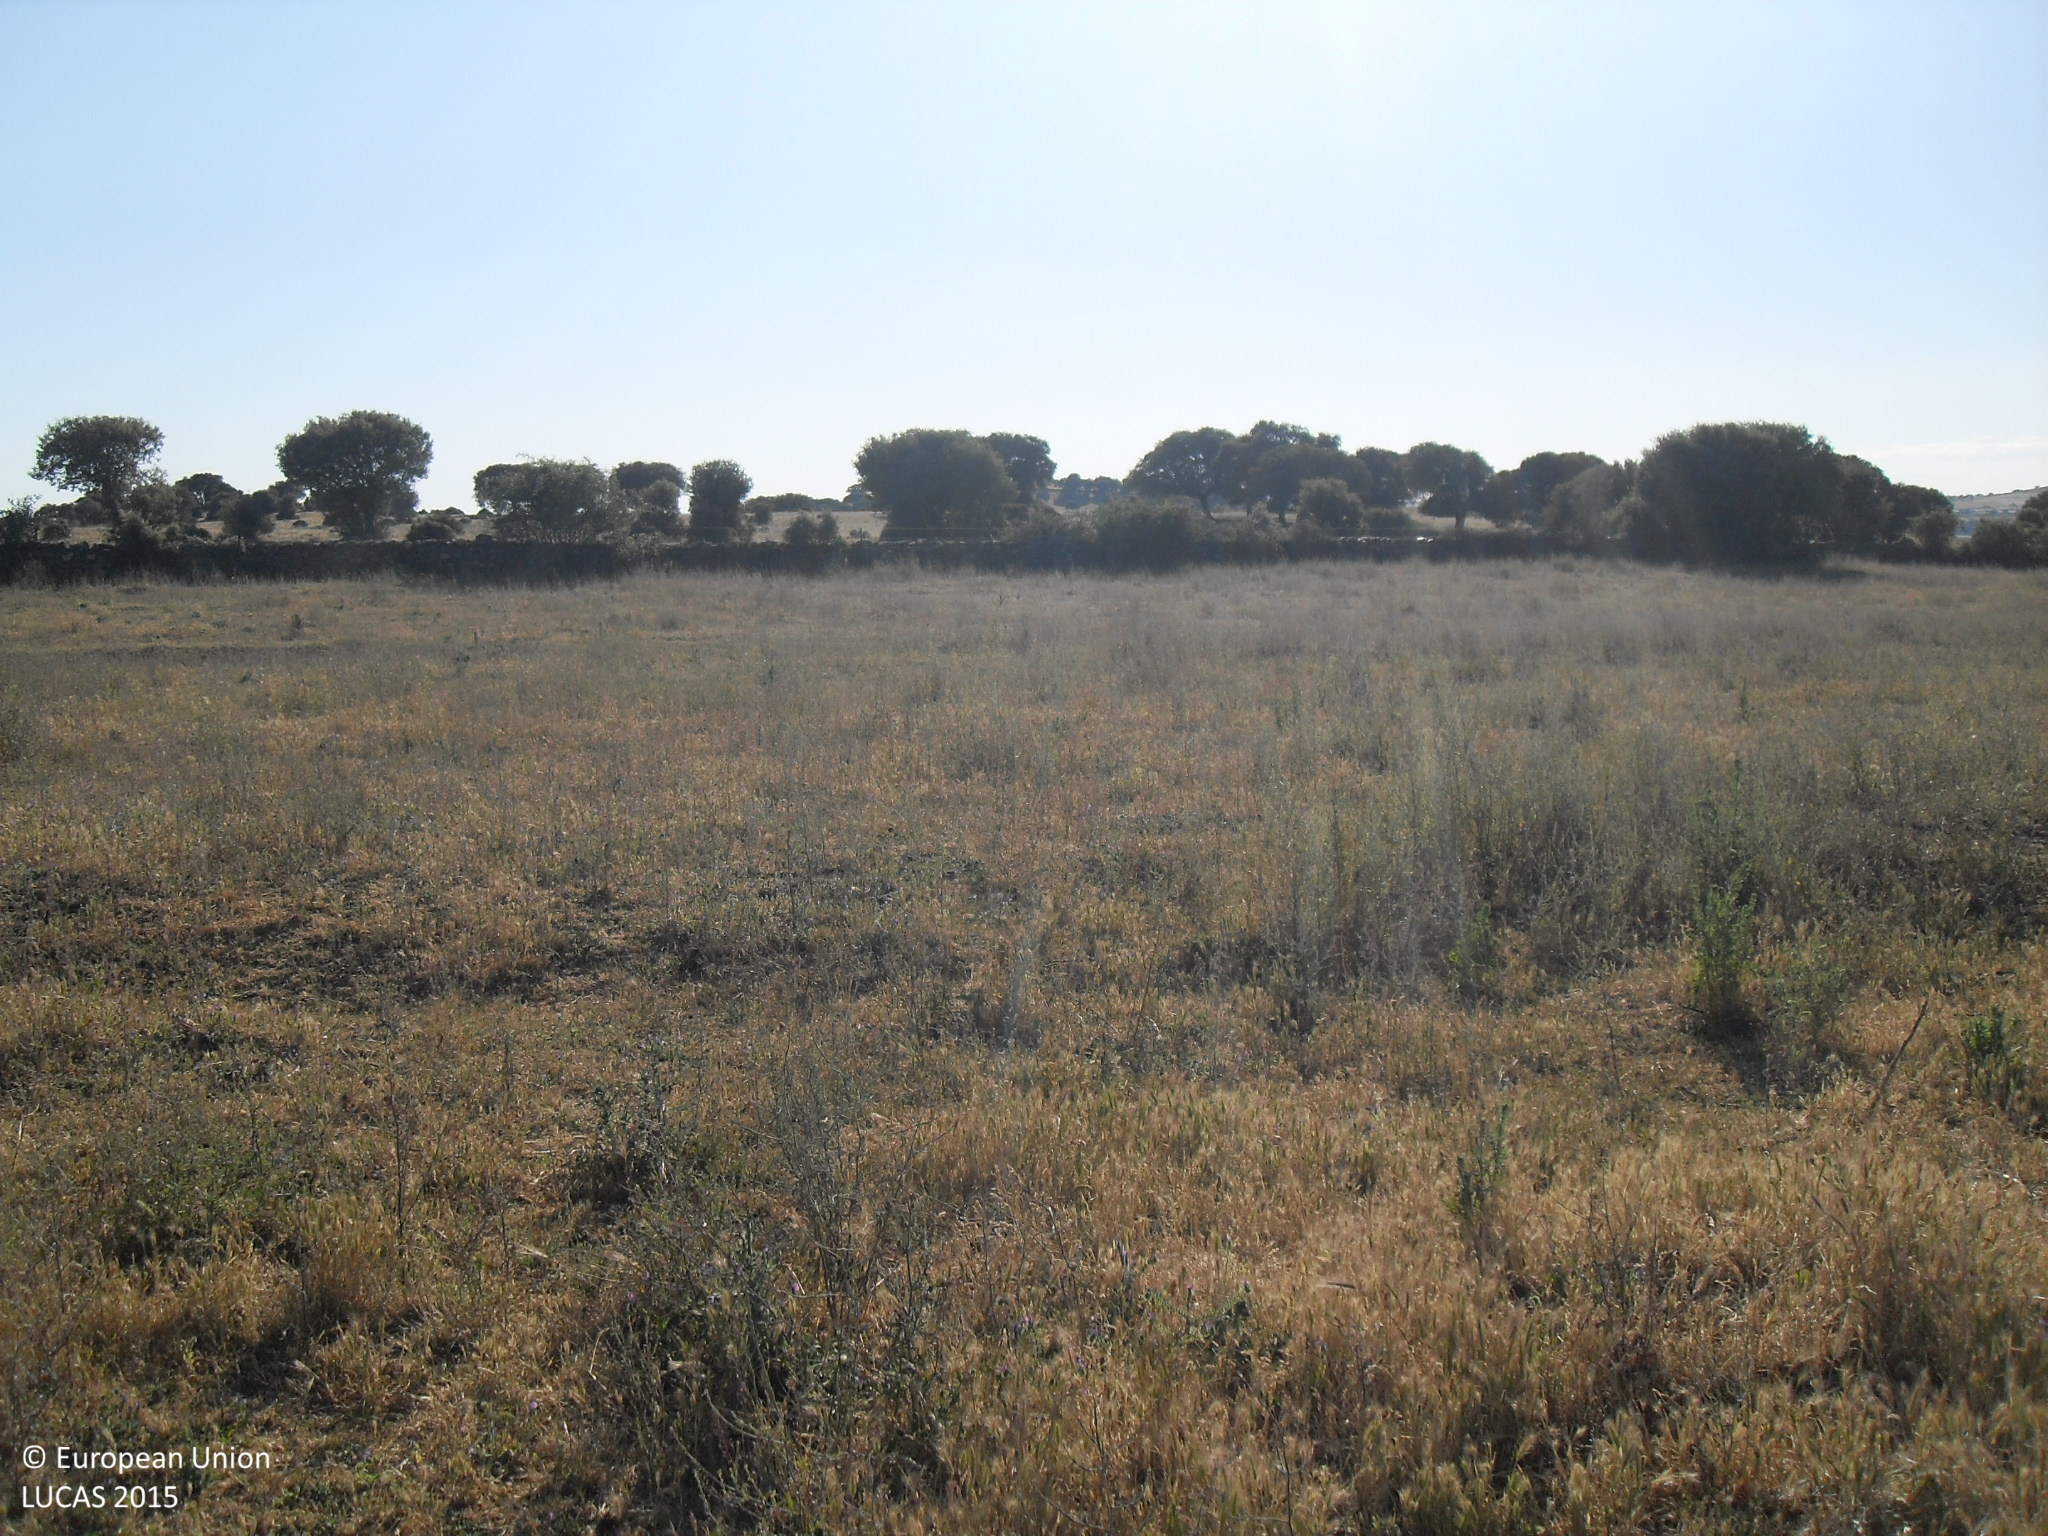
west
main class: Grassland
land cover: Grassland without tree/shrub cover
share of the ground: > 75 %
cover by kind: herbaceous plants 100 %
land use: Agriculture (excluding fallow land and kitchen gardens)
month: June
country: ES
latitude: 40.5801
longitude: -5.5575
